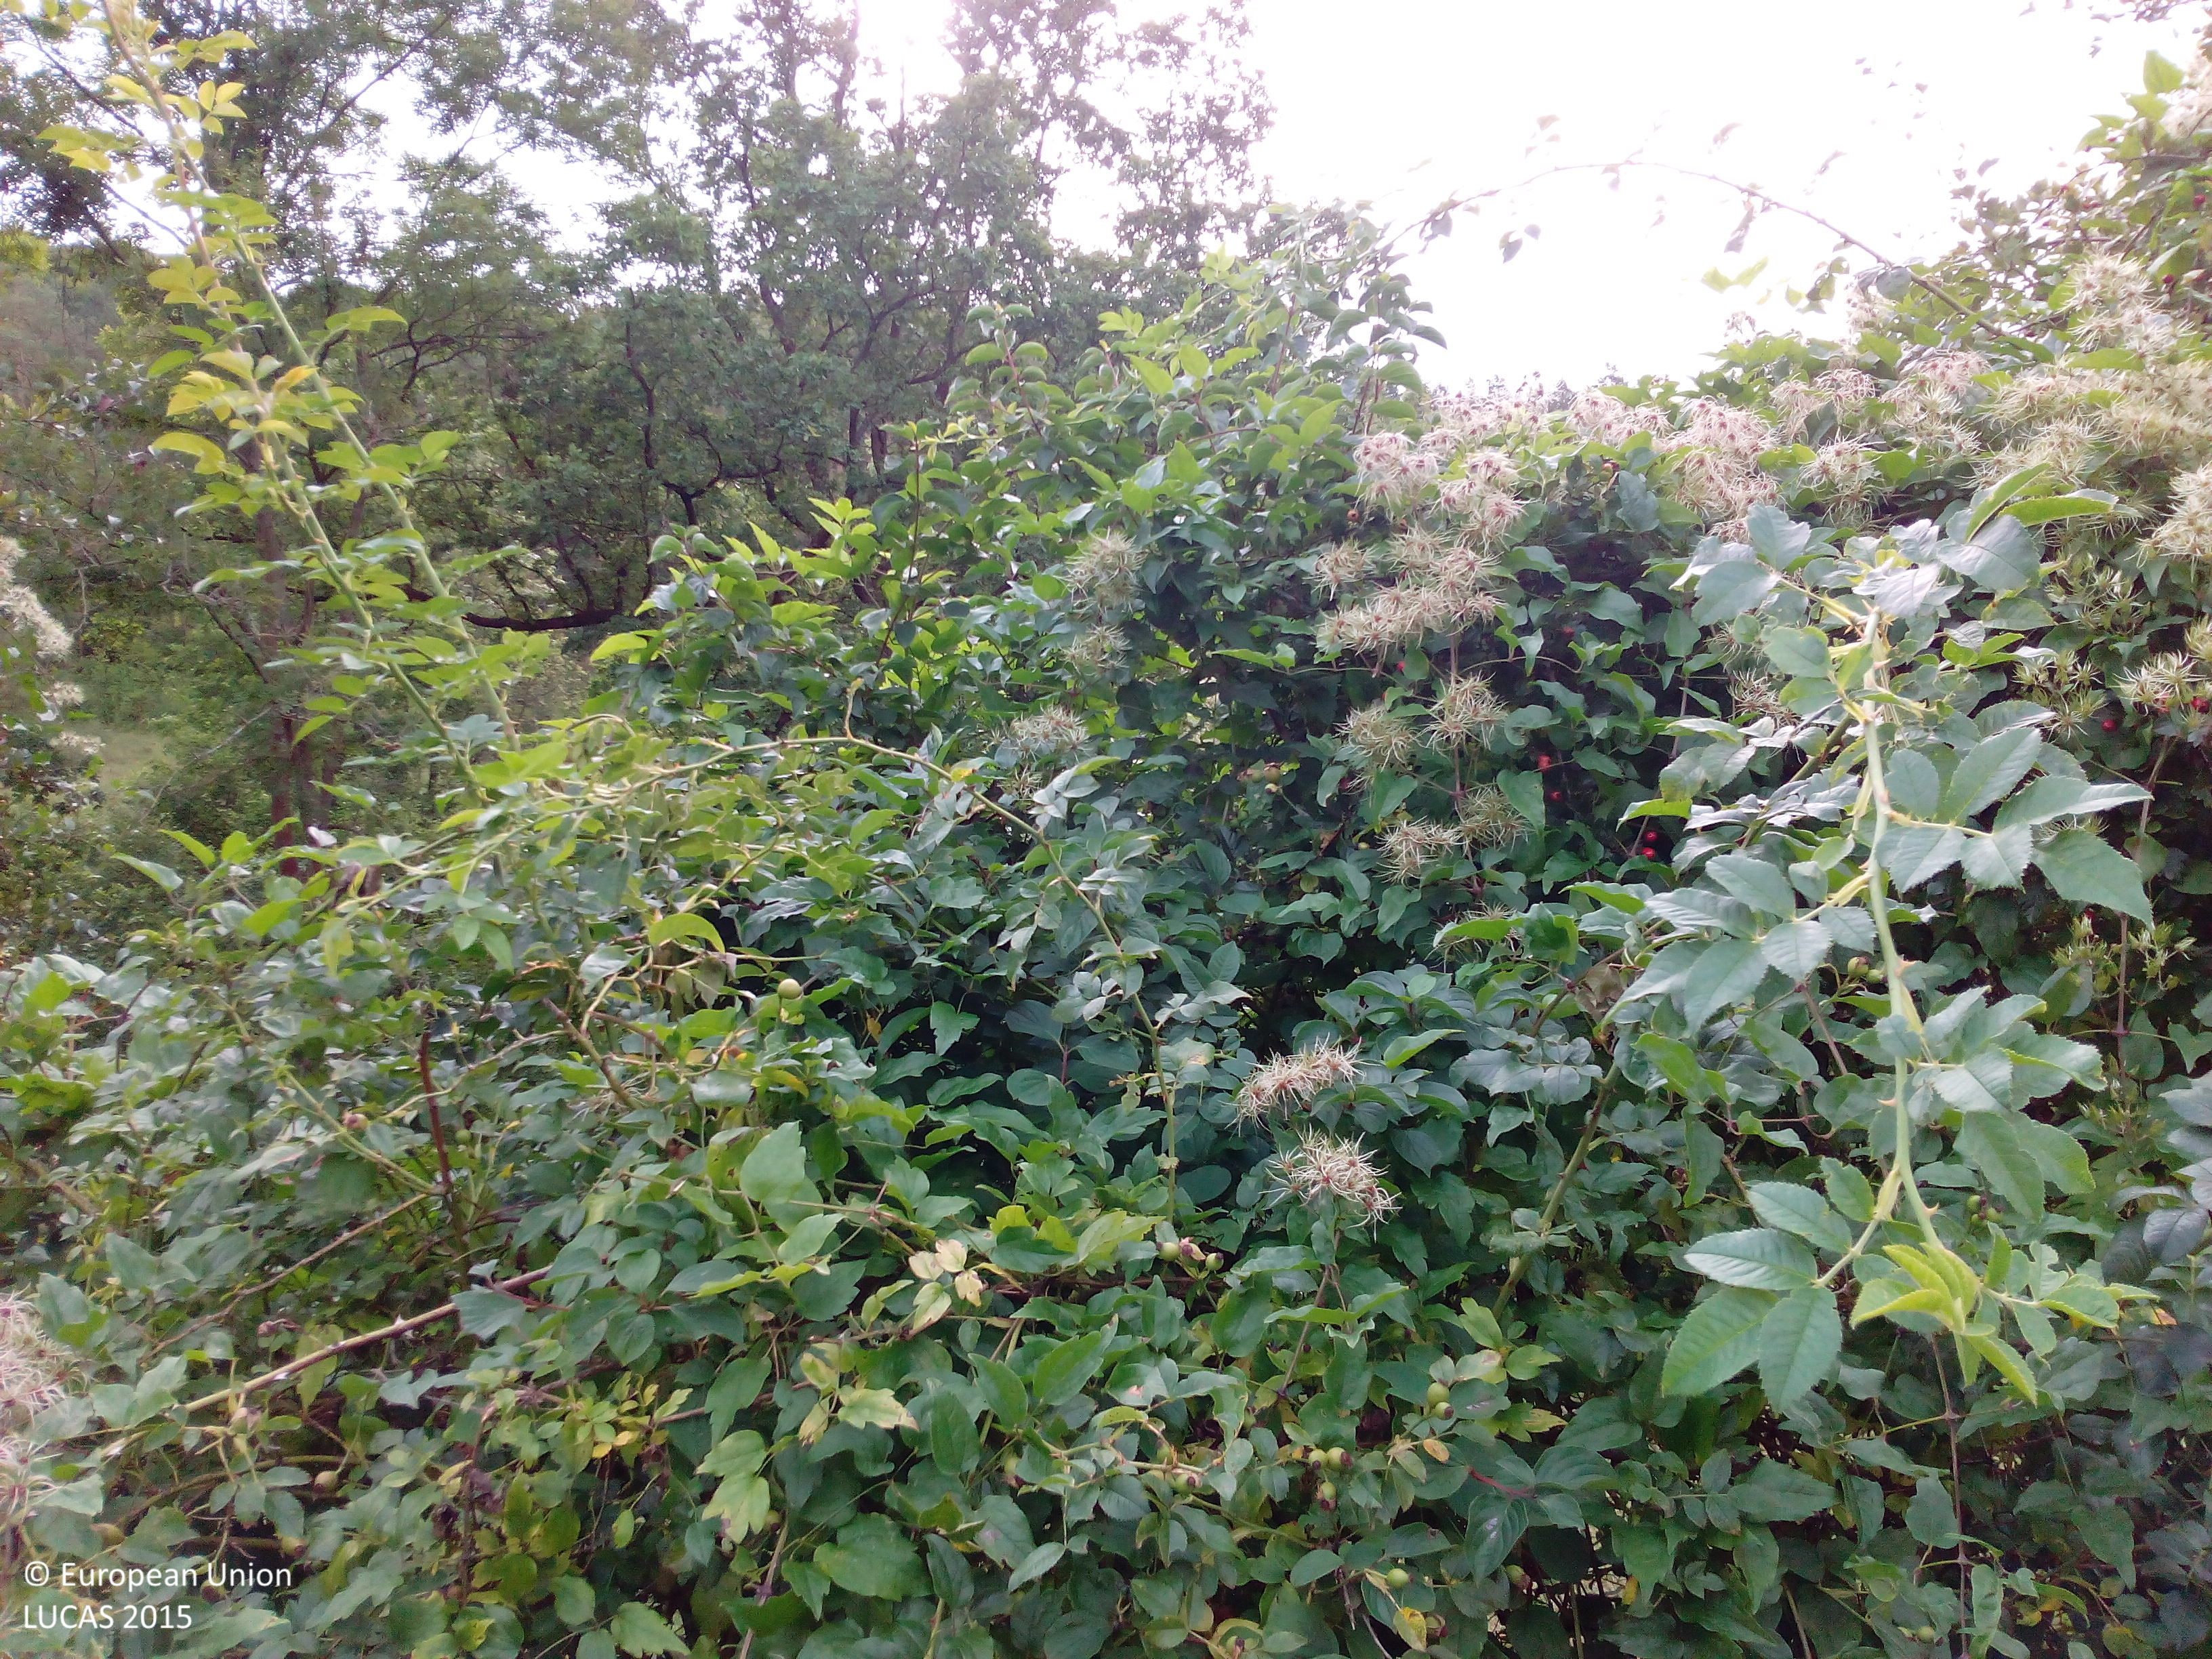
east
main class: Grassland
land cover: Grassland without tree/shrub cover
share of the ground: > 75 %
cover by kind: herbaceous plants 95 %, shrubs 5 %
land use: Agriculture (excluding fallow land and kitchen gardens)
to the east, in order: Grassland without tree/shrub cover; Other mixed woodland; Grassland without tree/shrub cover; Other mixed woodland; Broadleaved woodland; Other mixed woodland
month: August
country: DE
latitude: 51.1368
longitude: 10.2715
